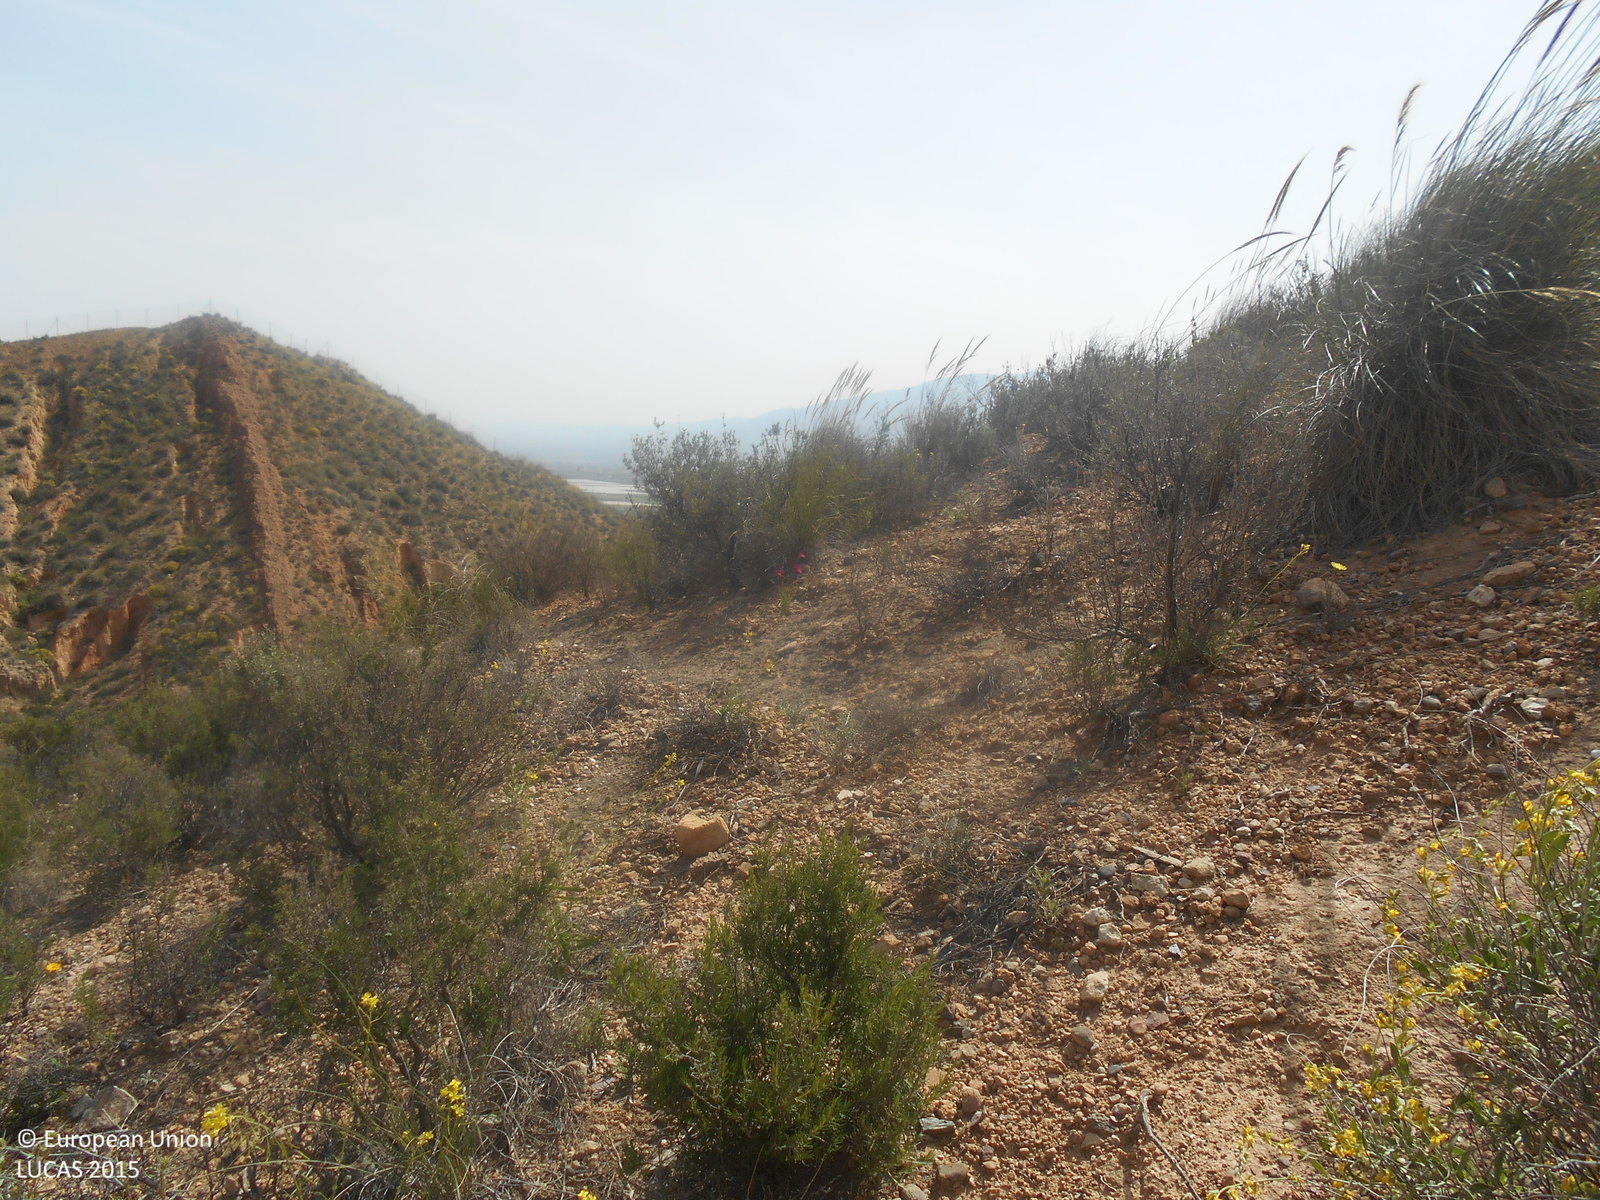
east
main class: Shrubland
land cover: Shrubland without tree cover
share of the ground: 25 - 50 %
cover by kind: shrubs 40 %, unconsolidated bare surface 40 %, herbaceous plants 20 %
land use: Semi-natural and natural areas not in use
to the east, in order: Shrubland without tree cover; Tracks; Shrubland without tree cover; Fences; Shrubland without tree cover; Ditches and canals; Other bare soil; Ditches and canals; Shruby margins; Tracks; Inland fresh water bodies
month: April
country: ES
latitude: 37.8637
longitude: -1.4074
